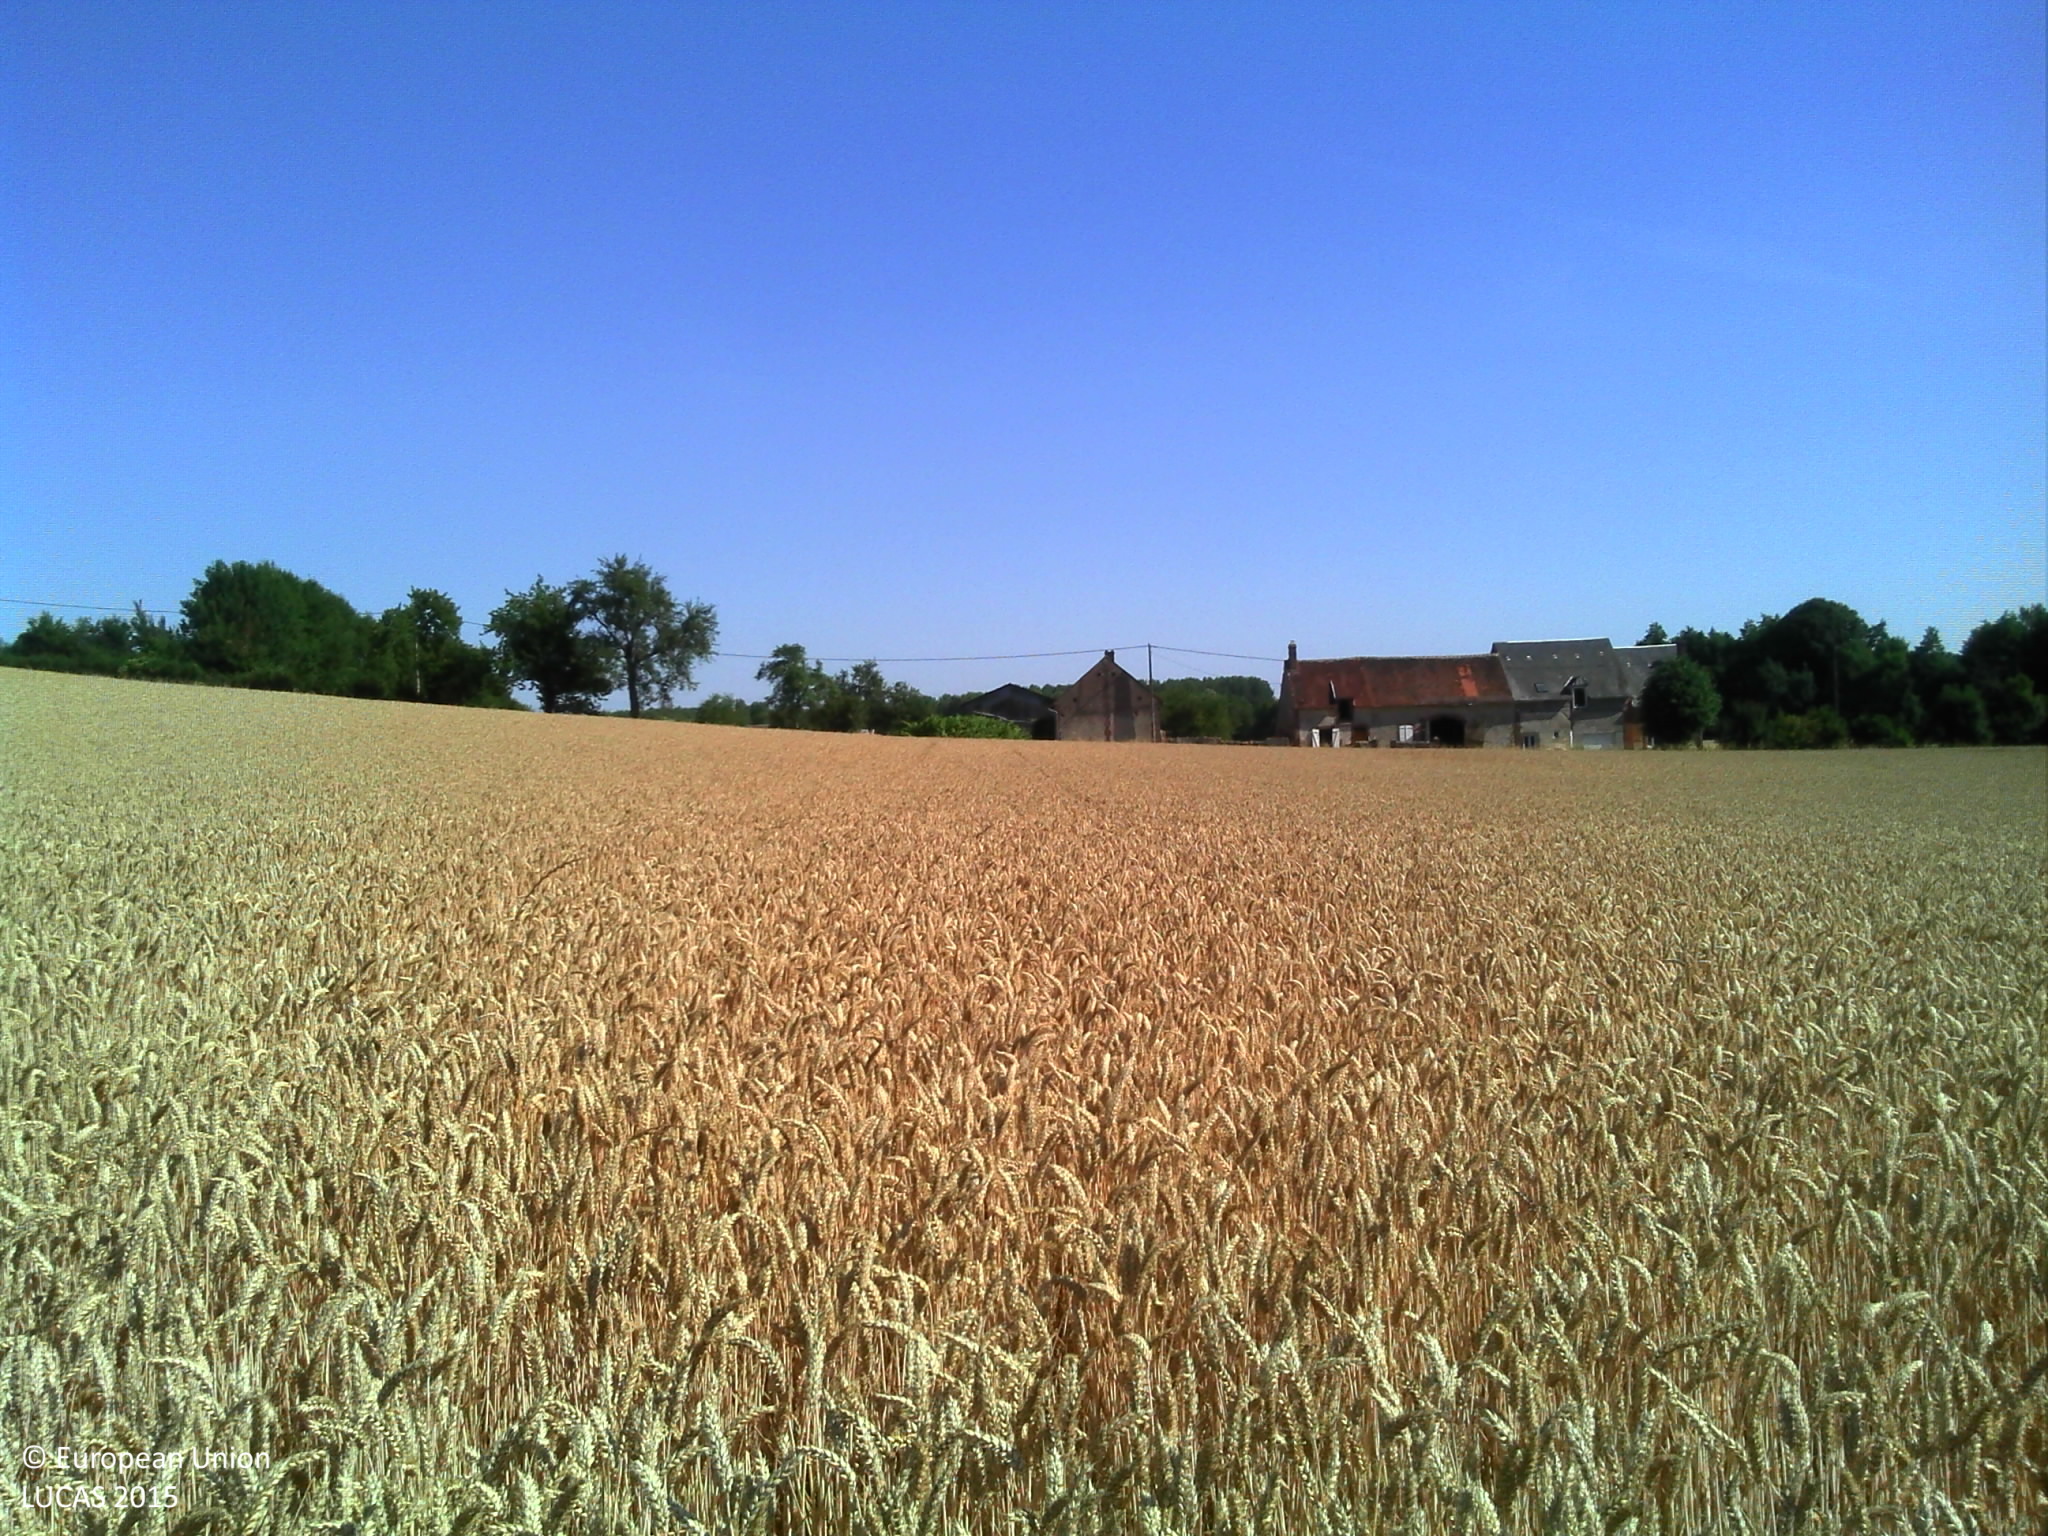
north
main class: Cropland
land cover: Common wheat
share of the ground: > 75 %
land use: Agriculture (excluding fallow land and kitchen gardens)
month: July
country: FR
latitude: 47.9316
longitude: 3.0465
